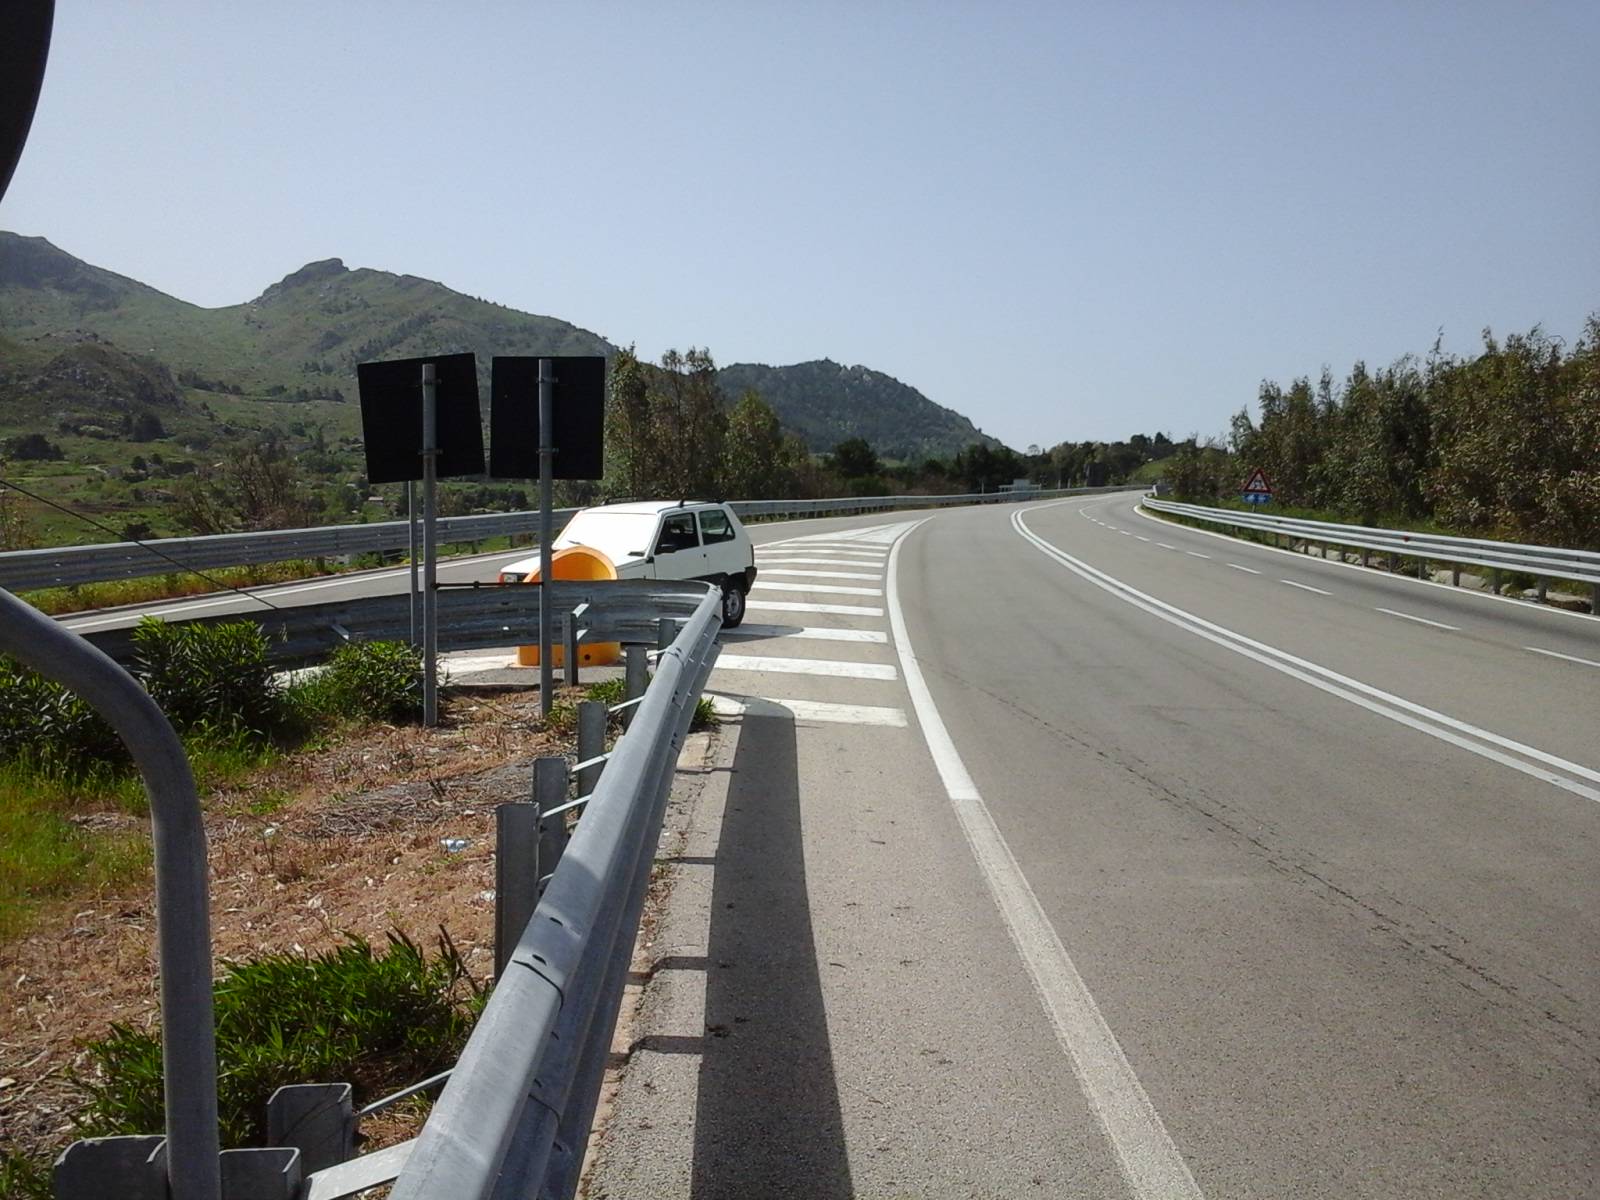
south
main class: Woodland
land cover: Broadleaved woodland
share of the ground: 25 - 50 %
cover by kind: shrubs 65 %, broadleaved forest trees 35 %
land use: Agriculture (excluding fallow land and kitchen gardens)
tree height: < 5 m
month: May
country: IT
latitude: 38.0191
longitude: 13.2461
